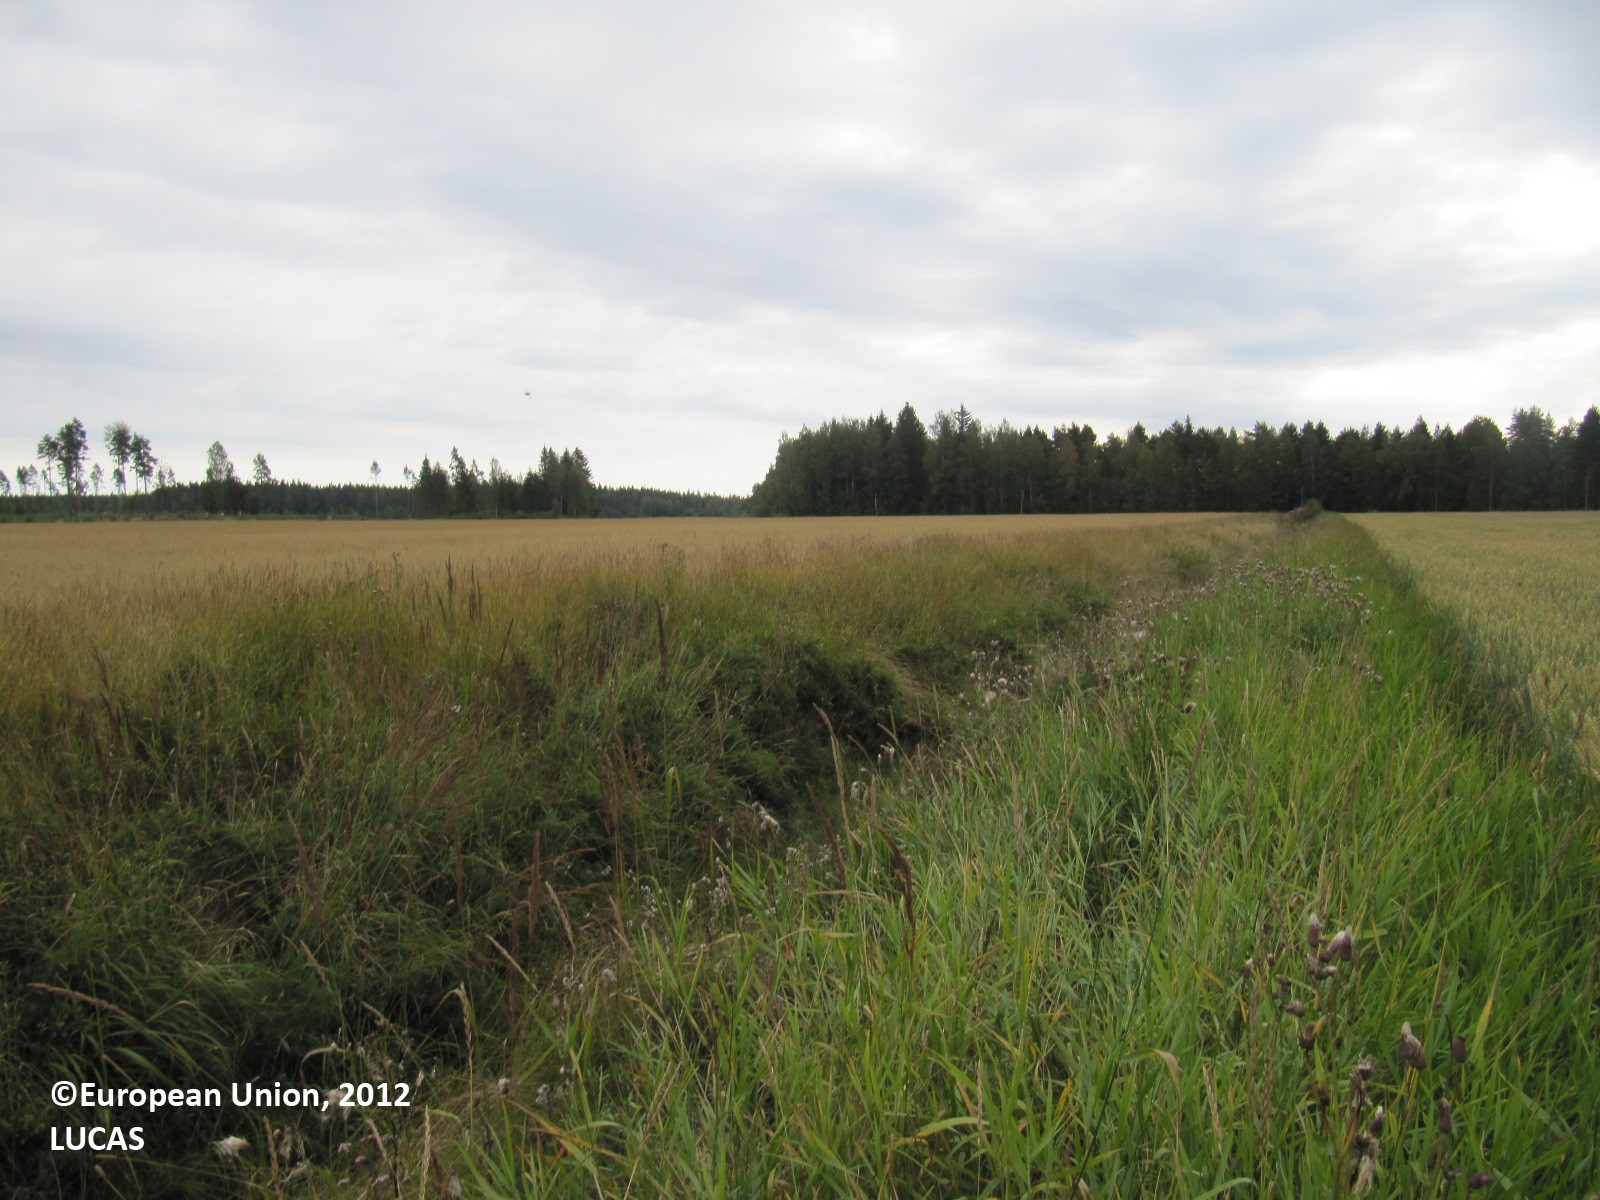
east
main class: Cropland
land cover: Common wheat
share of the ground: > 75 %
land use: Agriculture (excluding fallow land and kitchen gardens)
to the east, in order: Common wheat; Spontaneously vegetated surfaces; Ditches and canals; Spontaneously vegetated surfaces; Oats
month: August
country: FI
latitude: 61.0970
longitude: 22.9638
